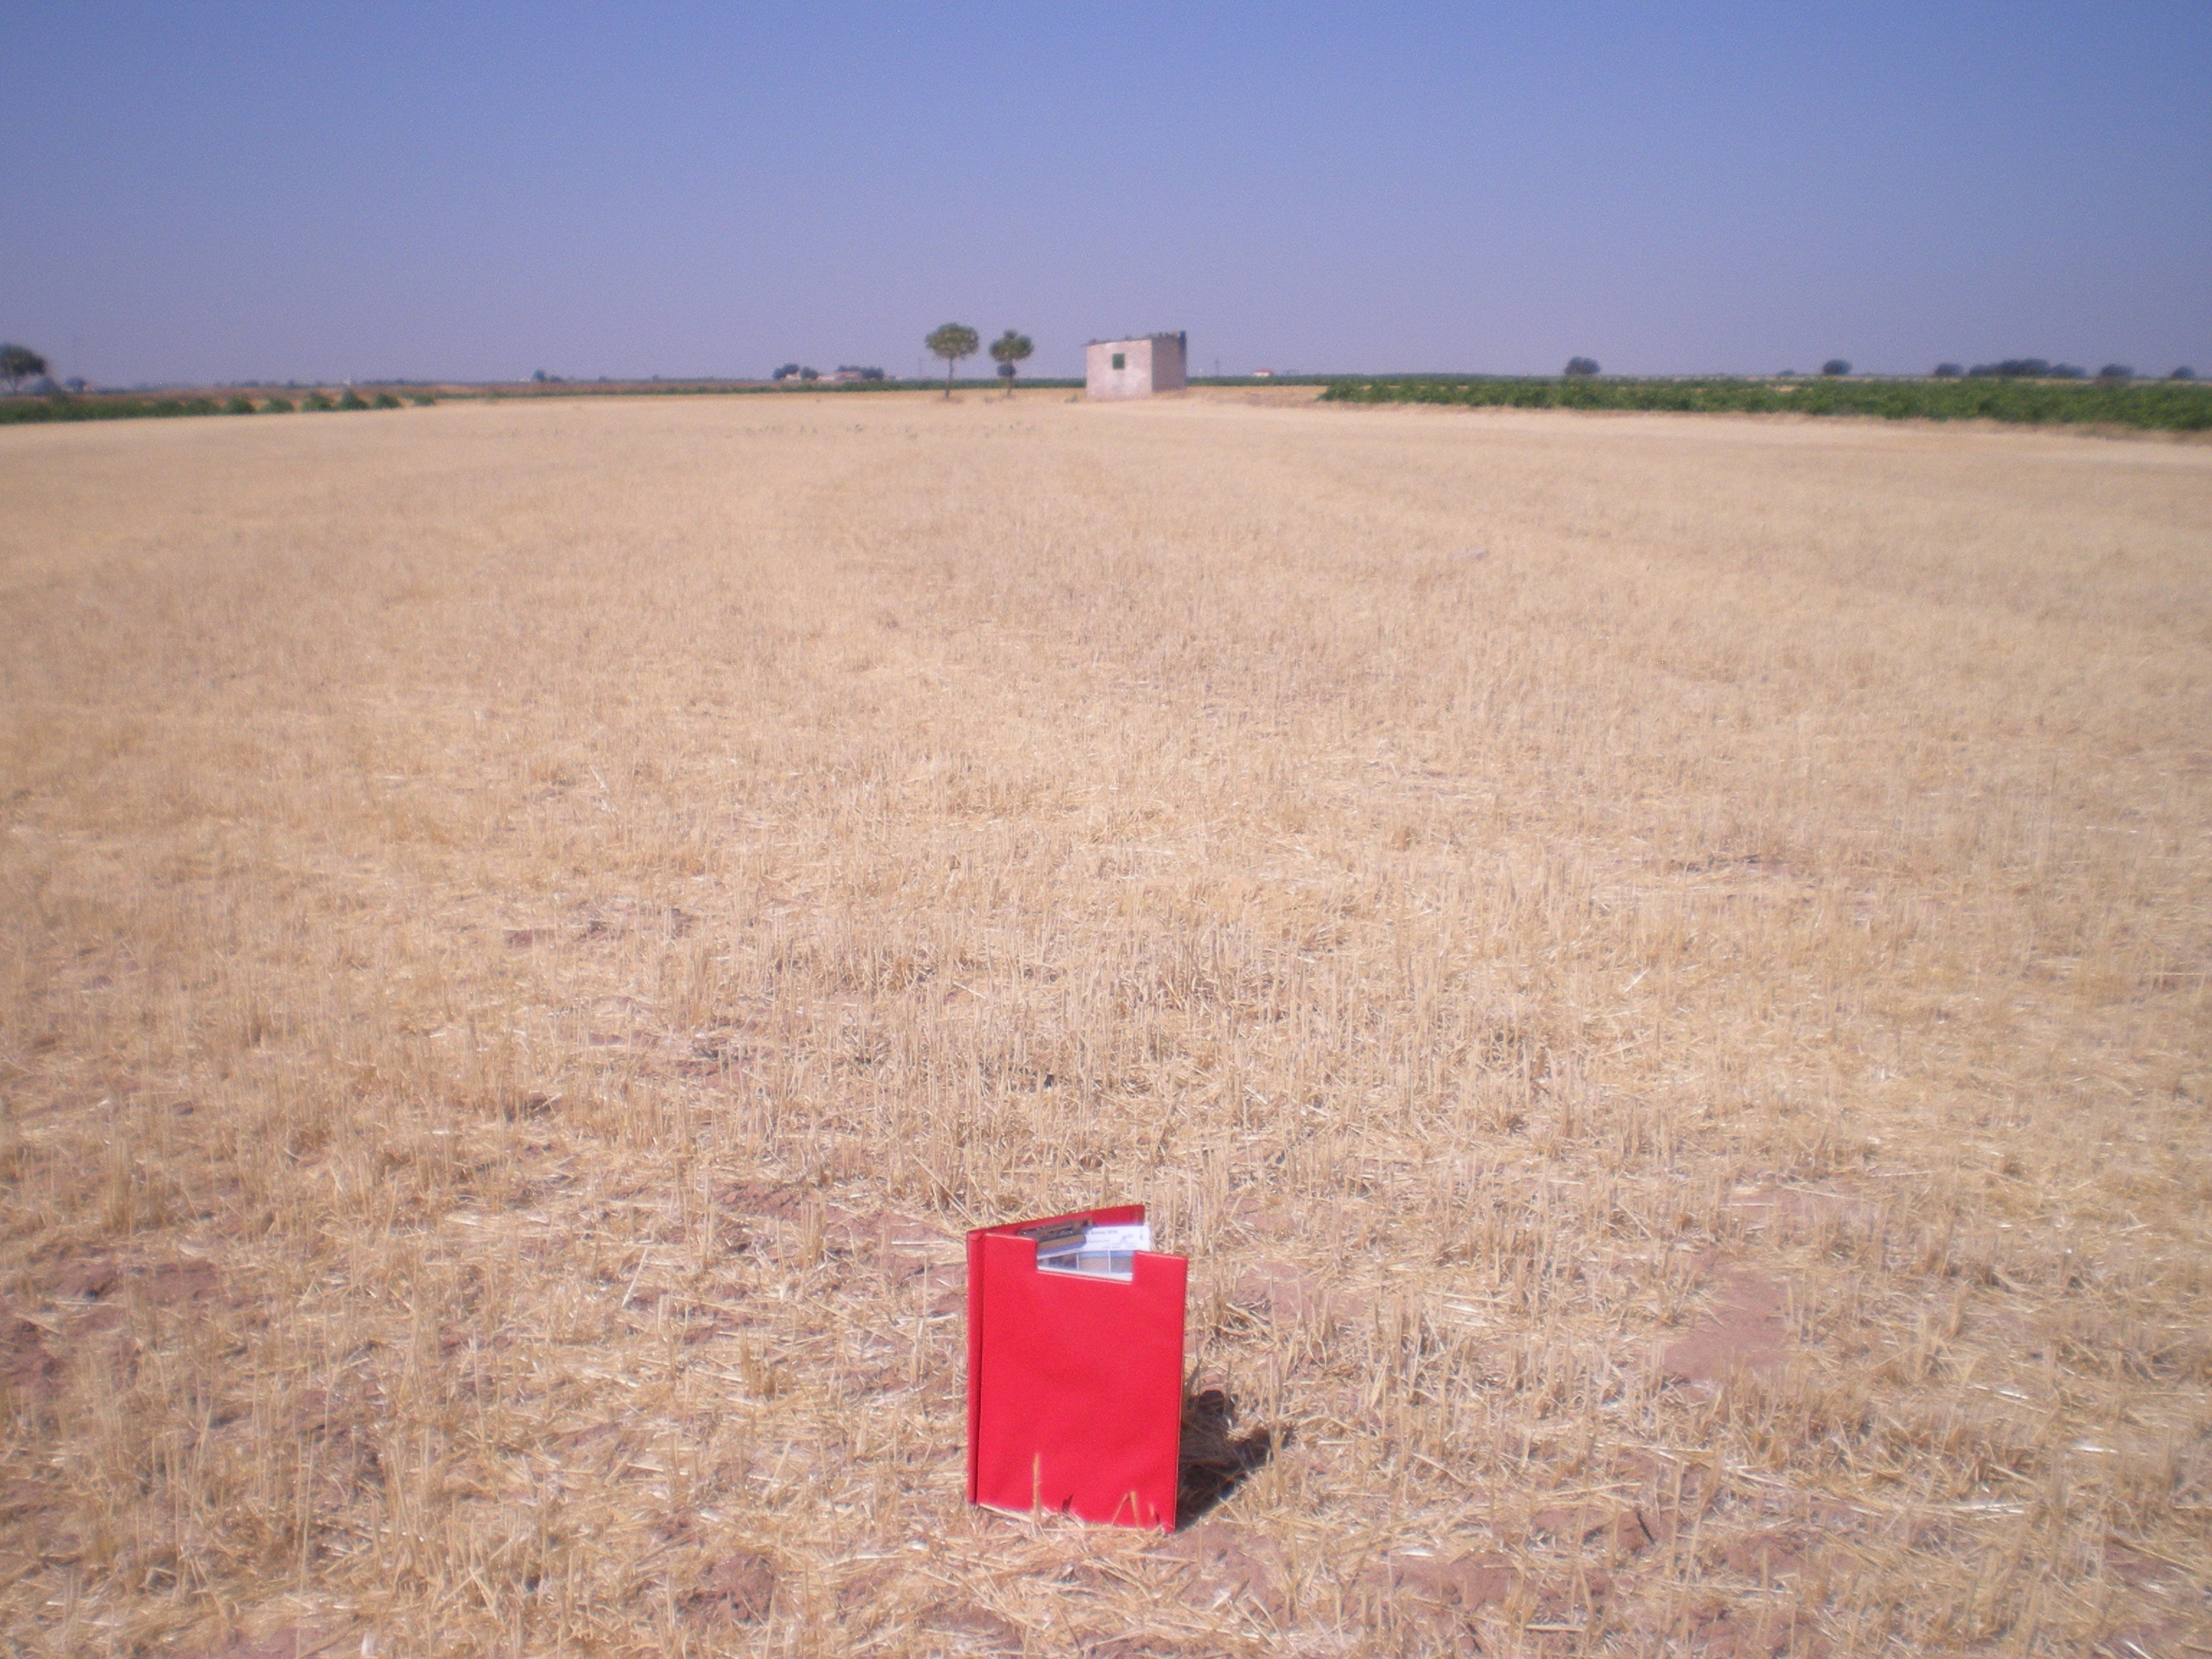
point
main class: Cropland
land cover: Barley
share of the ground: < 10 %
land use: Agriculture (excluding fallow land and kitchen gardens)
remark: Harvested field
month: July
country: ES
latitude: 39.3227
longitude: -3.0180
